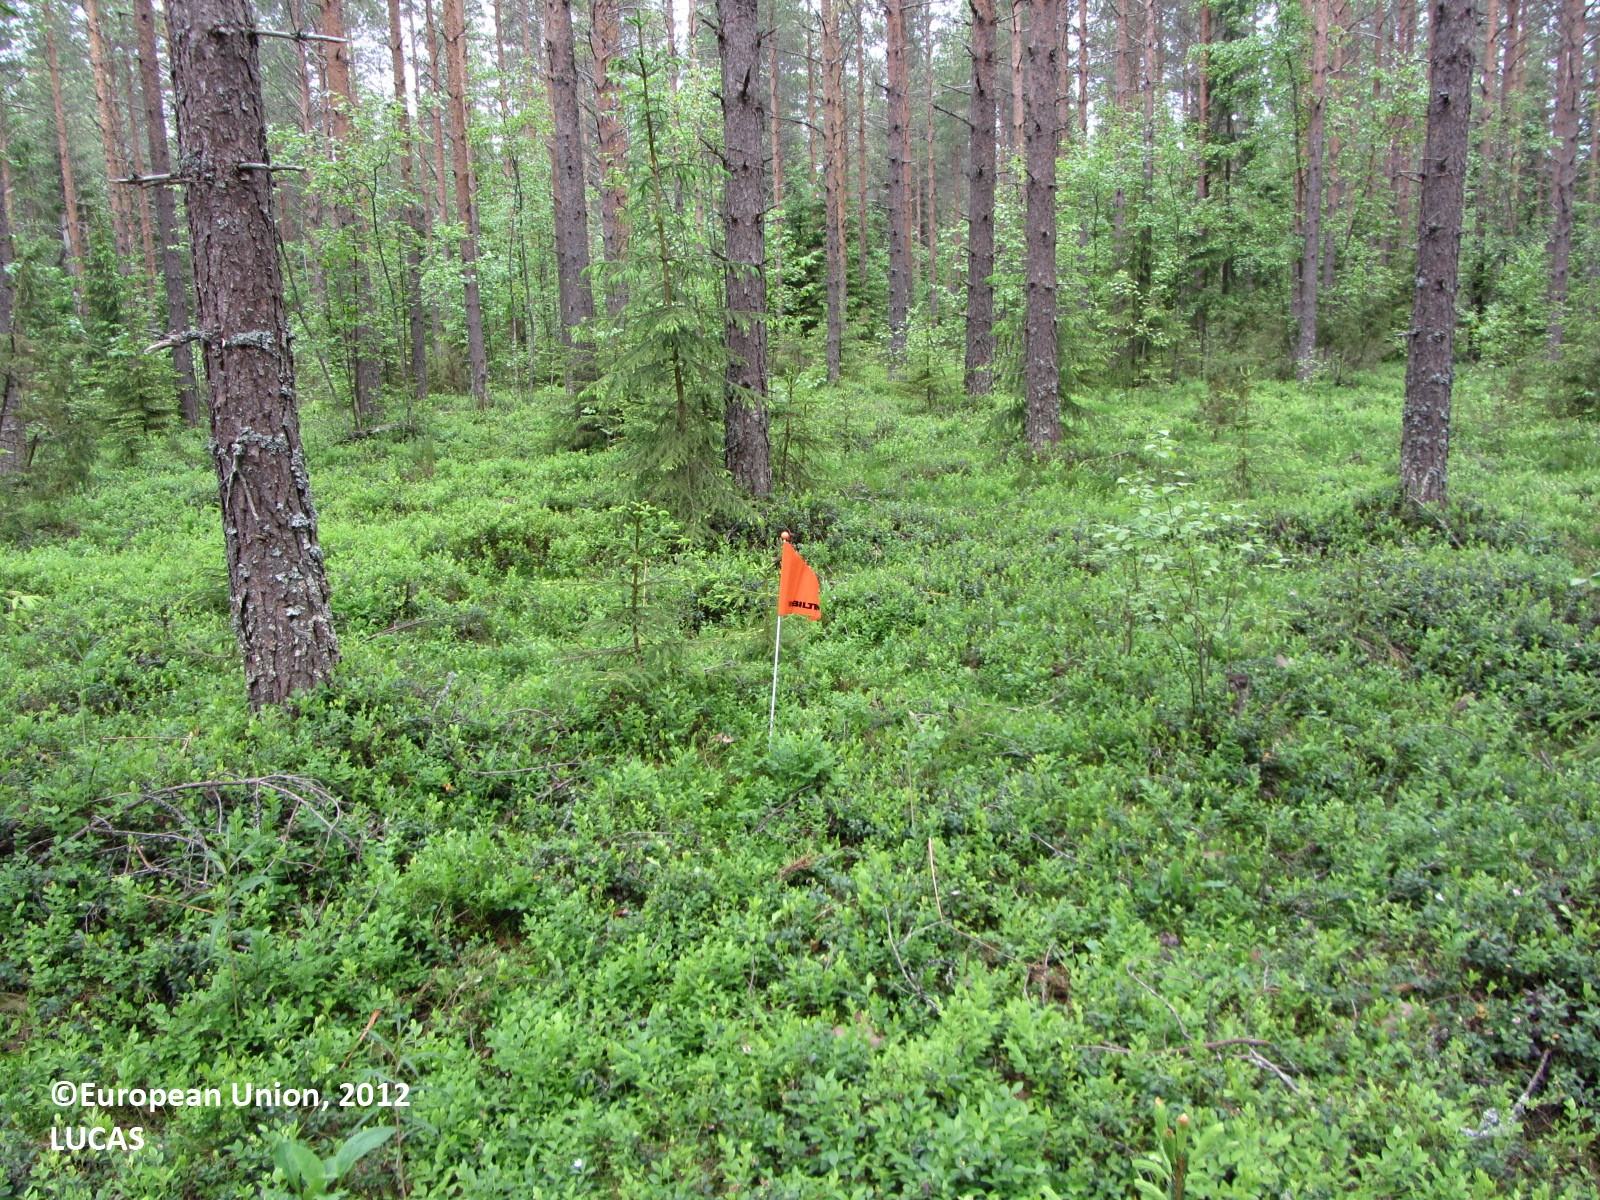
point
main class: Woodland
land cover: Pine dominated coniferous woodland
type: boreal forest
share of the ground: 50 - 75 %
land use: Forestry
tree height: > 5 m
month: June
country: FI
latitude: 62.4987
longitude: 25.1874
